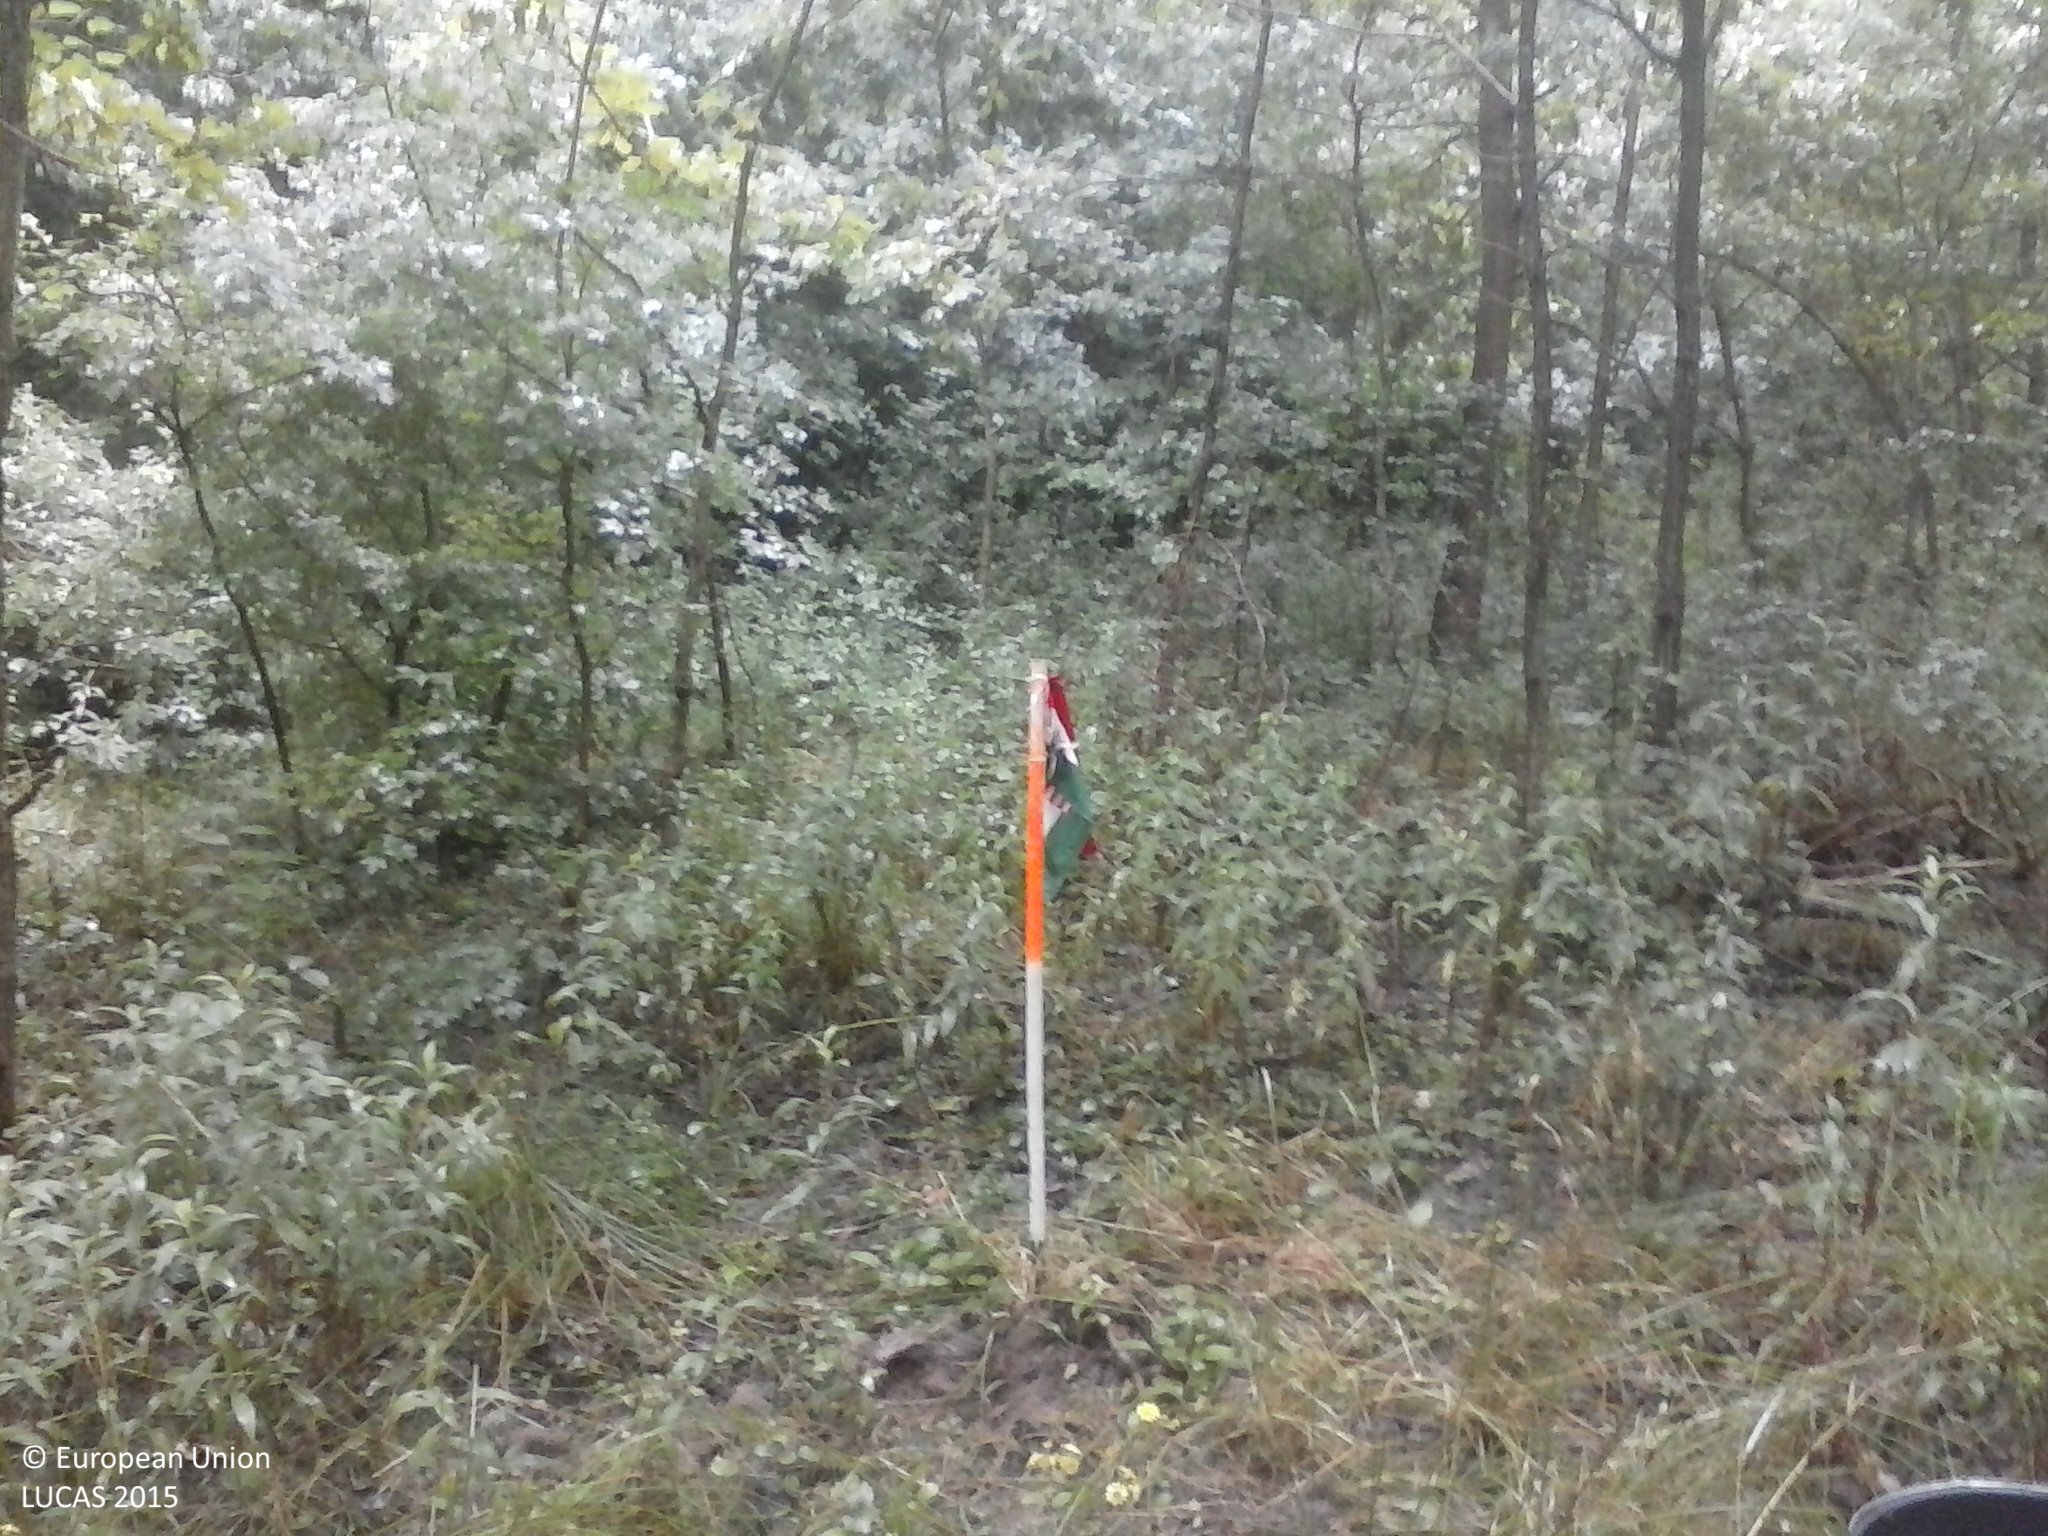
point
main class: Woodland
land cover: Broadleaved woodland
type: exotic forest
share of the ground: > 75 %
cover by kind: broadleaved forest trees 90 %, shrubs 5 %, herbaceous plants 5 %
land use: Forestry
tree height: > 5 m
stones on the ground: < 10 %
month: July
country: HU
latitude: 45.9519
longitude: 17.6283
